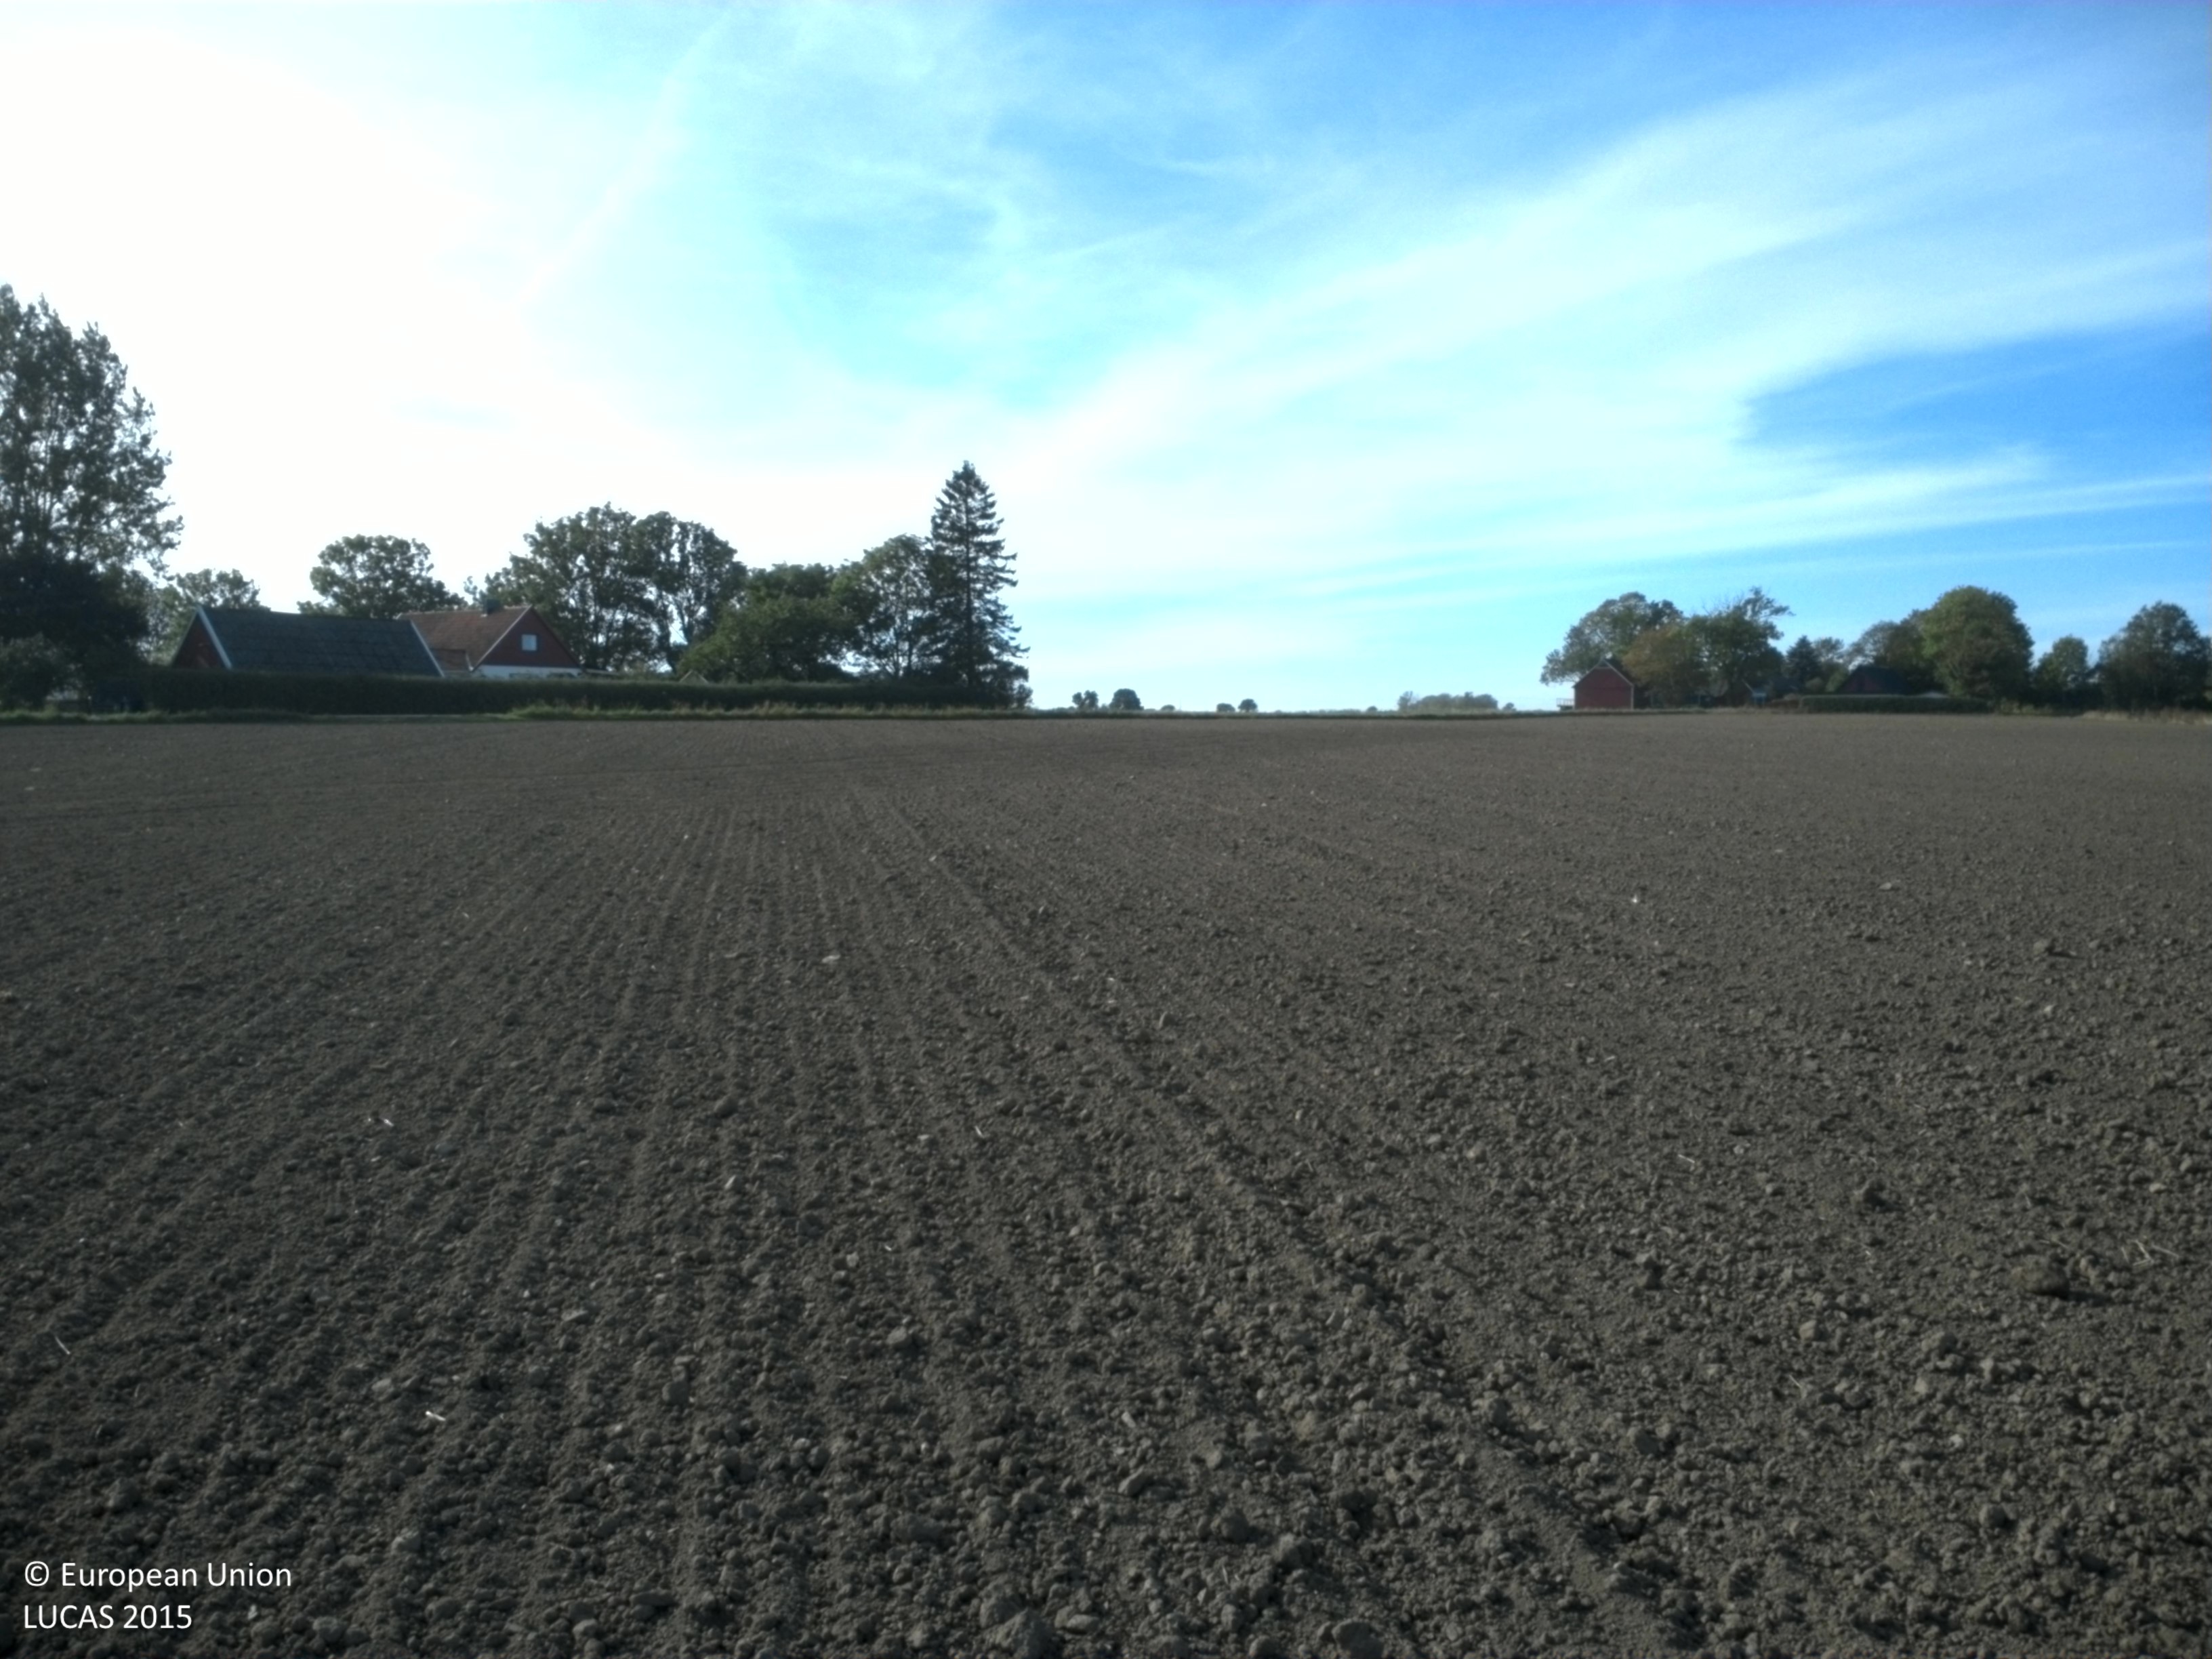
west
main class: Cropland
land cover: Common wheat
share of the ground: < 10 %
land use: Agriculture (excluding fallow land and kitchen gardens)
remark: Tilled/Sowed
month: October
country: SE
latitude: 55.7024
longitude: 13.7057
